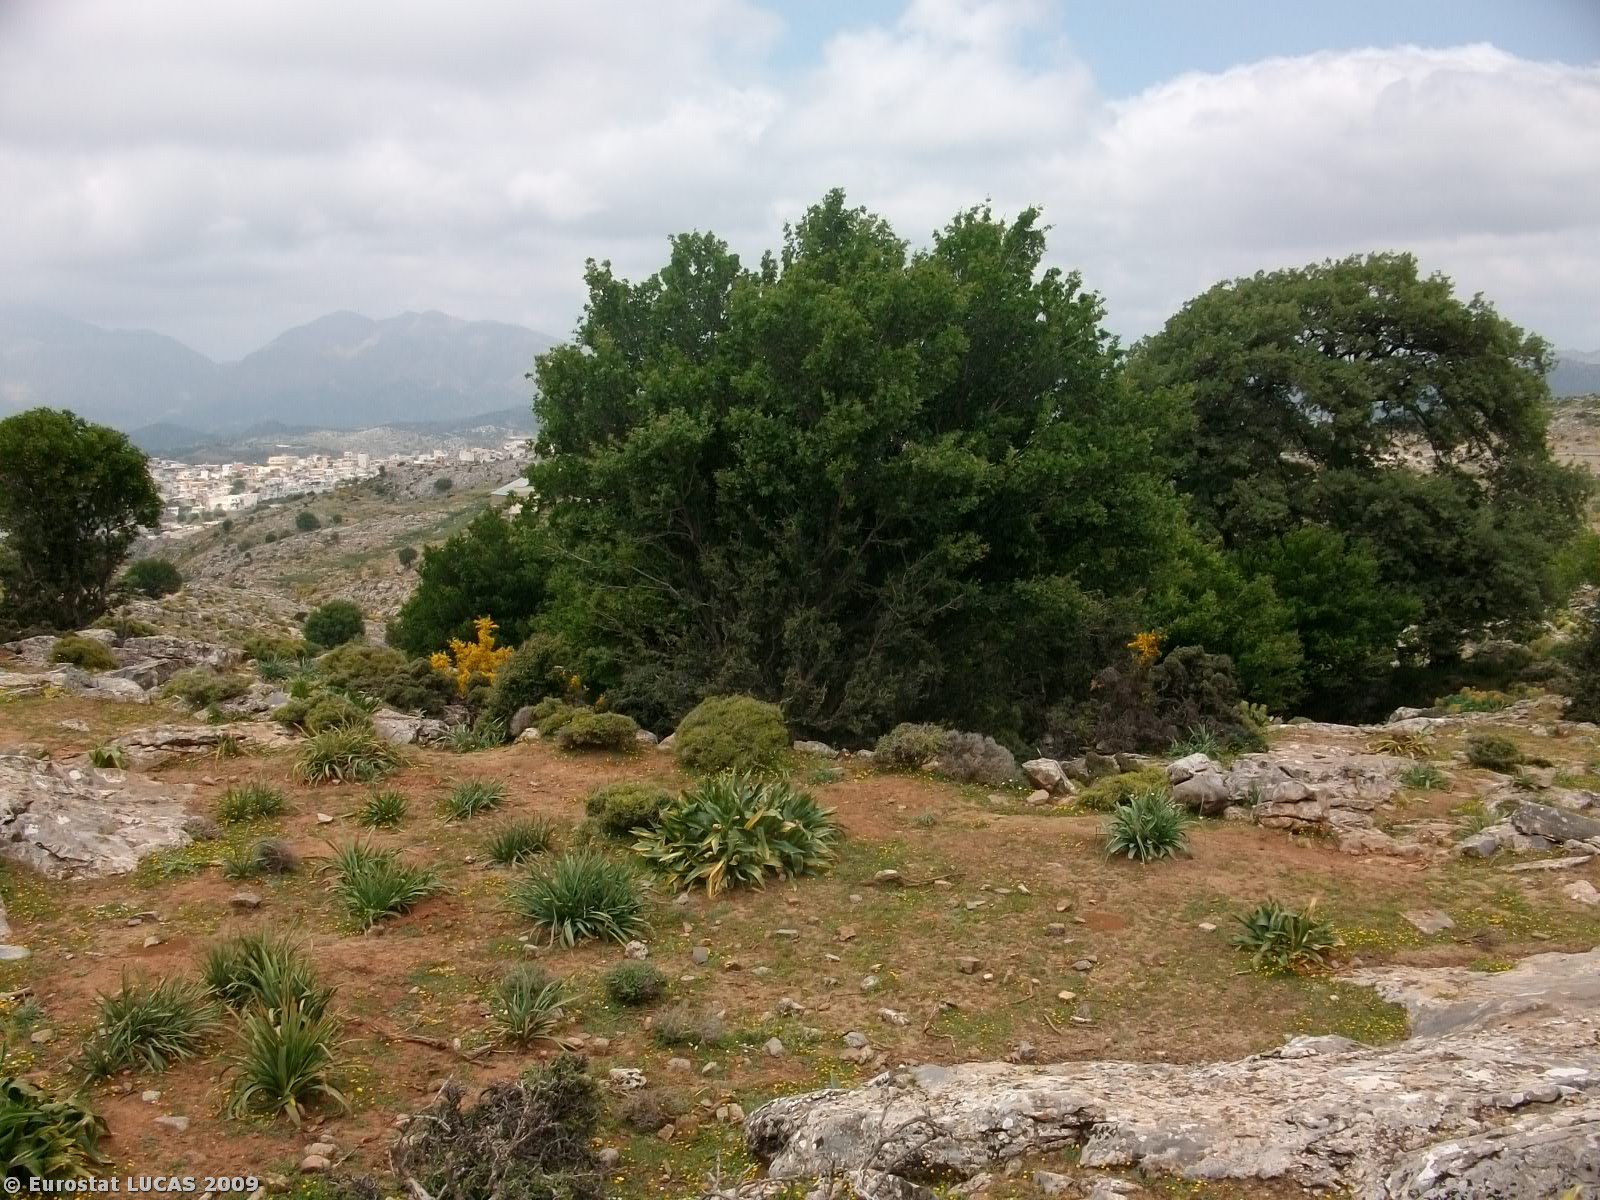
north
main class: Shrubland
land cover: Shrubland with sparse tree cover
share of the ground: > 75 %
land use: Agriculture (excluding fallow land and kitchen gardens)
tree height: < 5 m
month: May
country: GR
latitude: 35.2792
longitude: 24.8867
